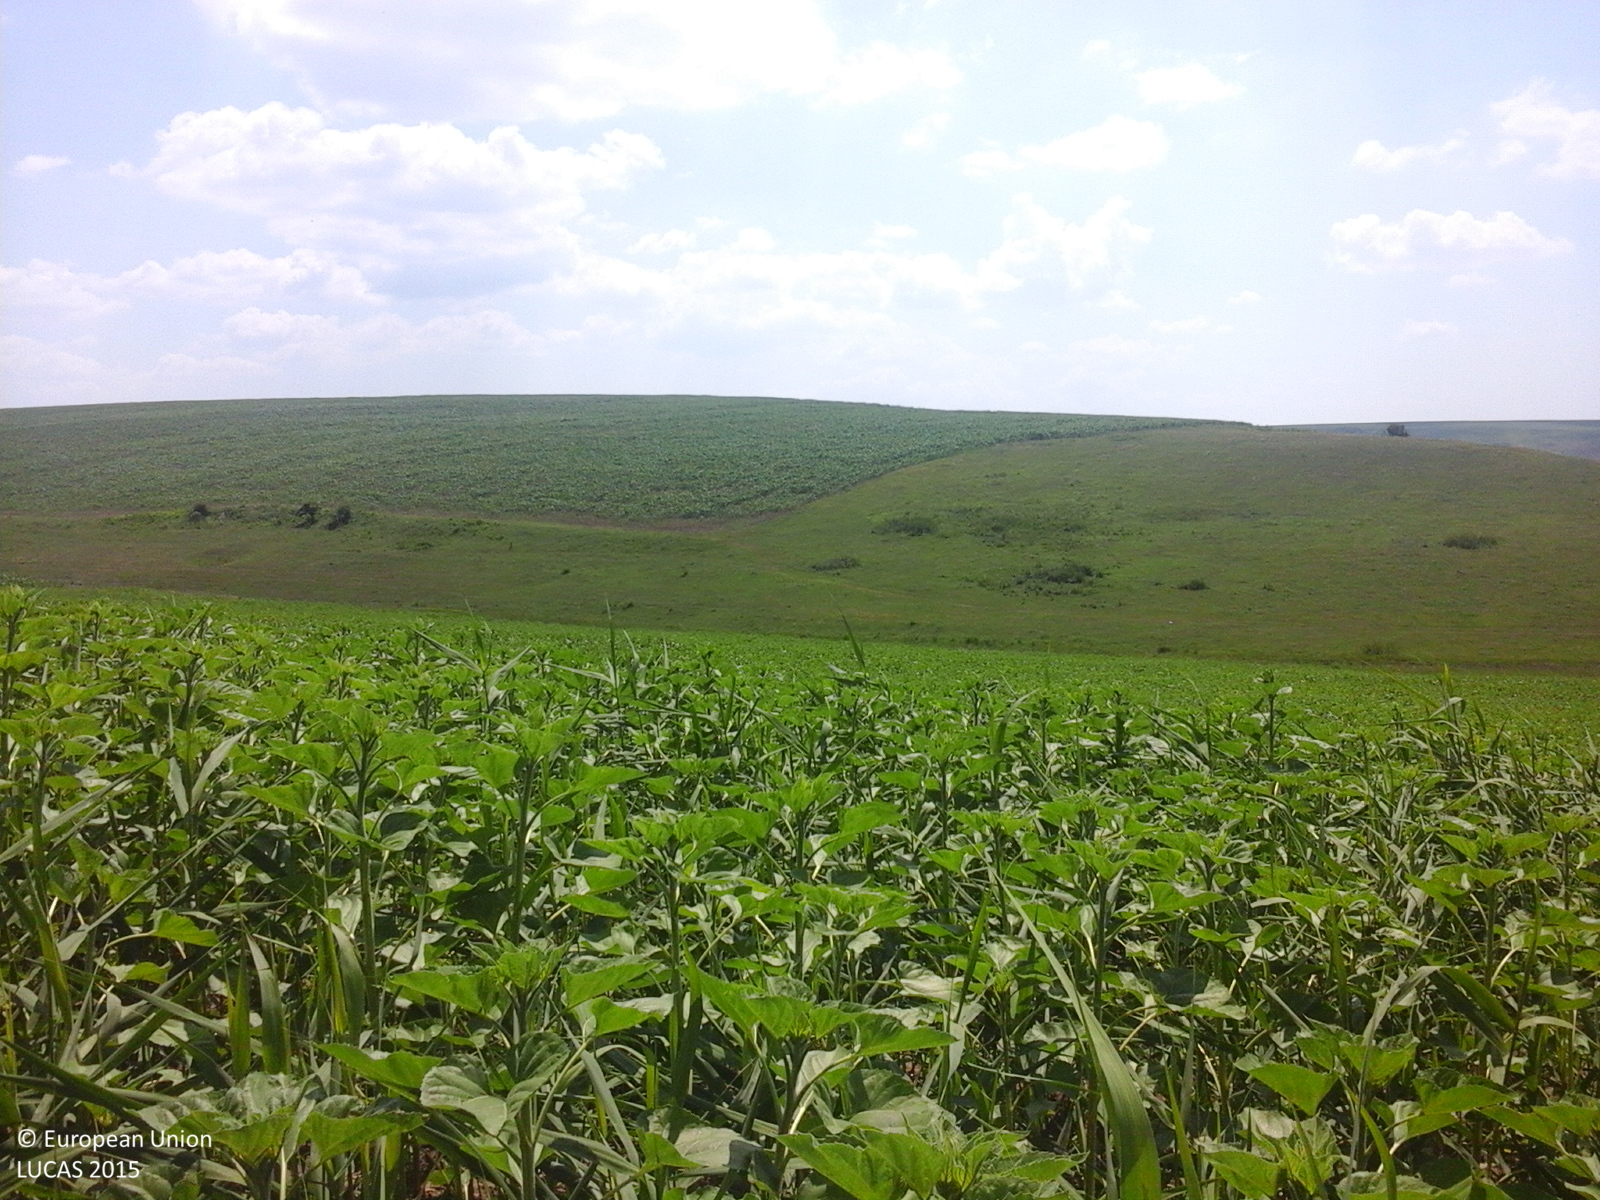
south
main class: Cropland
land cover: Sunflower
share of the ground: > 75 %
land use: Agriculture (excluding fallow land and kitchen gardens)
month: June
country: RO
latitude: 47.2516
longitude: 27.3824
